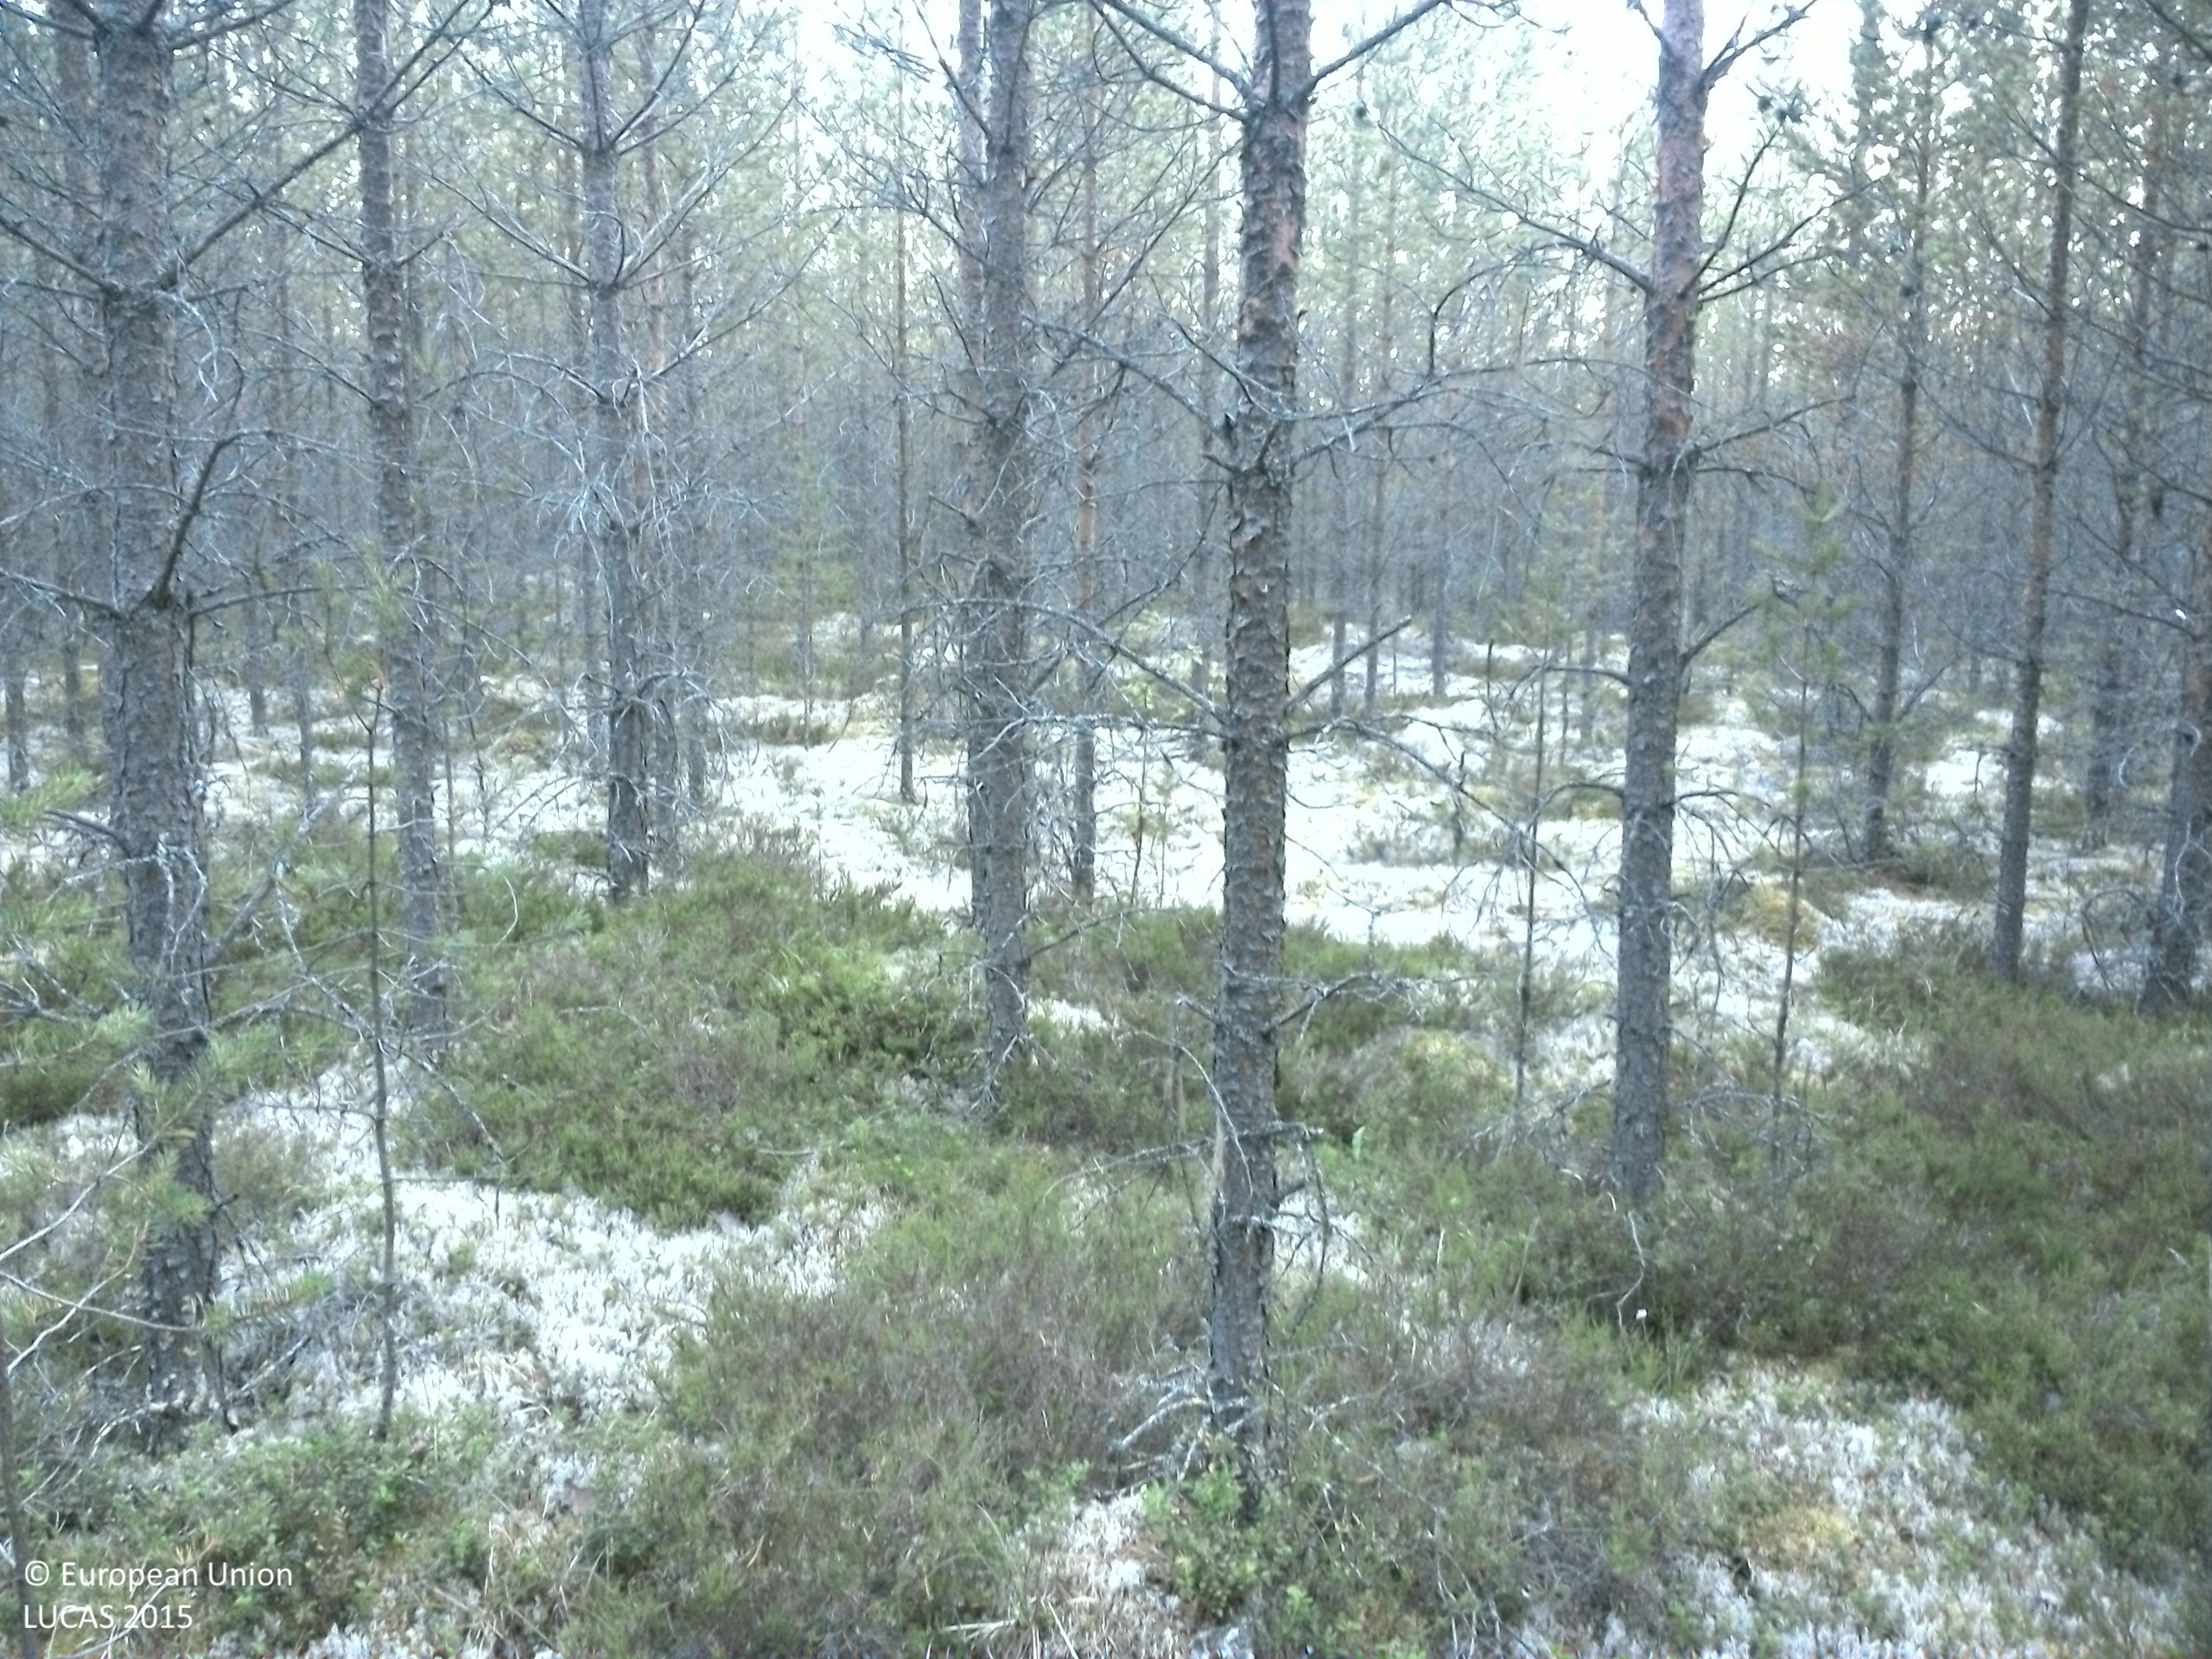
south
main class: Woodland
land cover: Pine dominated coniferous woodland
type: boreal forest
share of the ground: 25 - 50 %
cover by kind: lichens and mosses 45 %, coniferous forest trees 35 %, shrubs 20 %
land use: Forestry
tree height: > 5 m
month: August
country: SE
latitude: 63.6720
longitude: 16.3793
